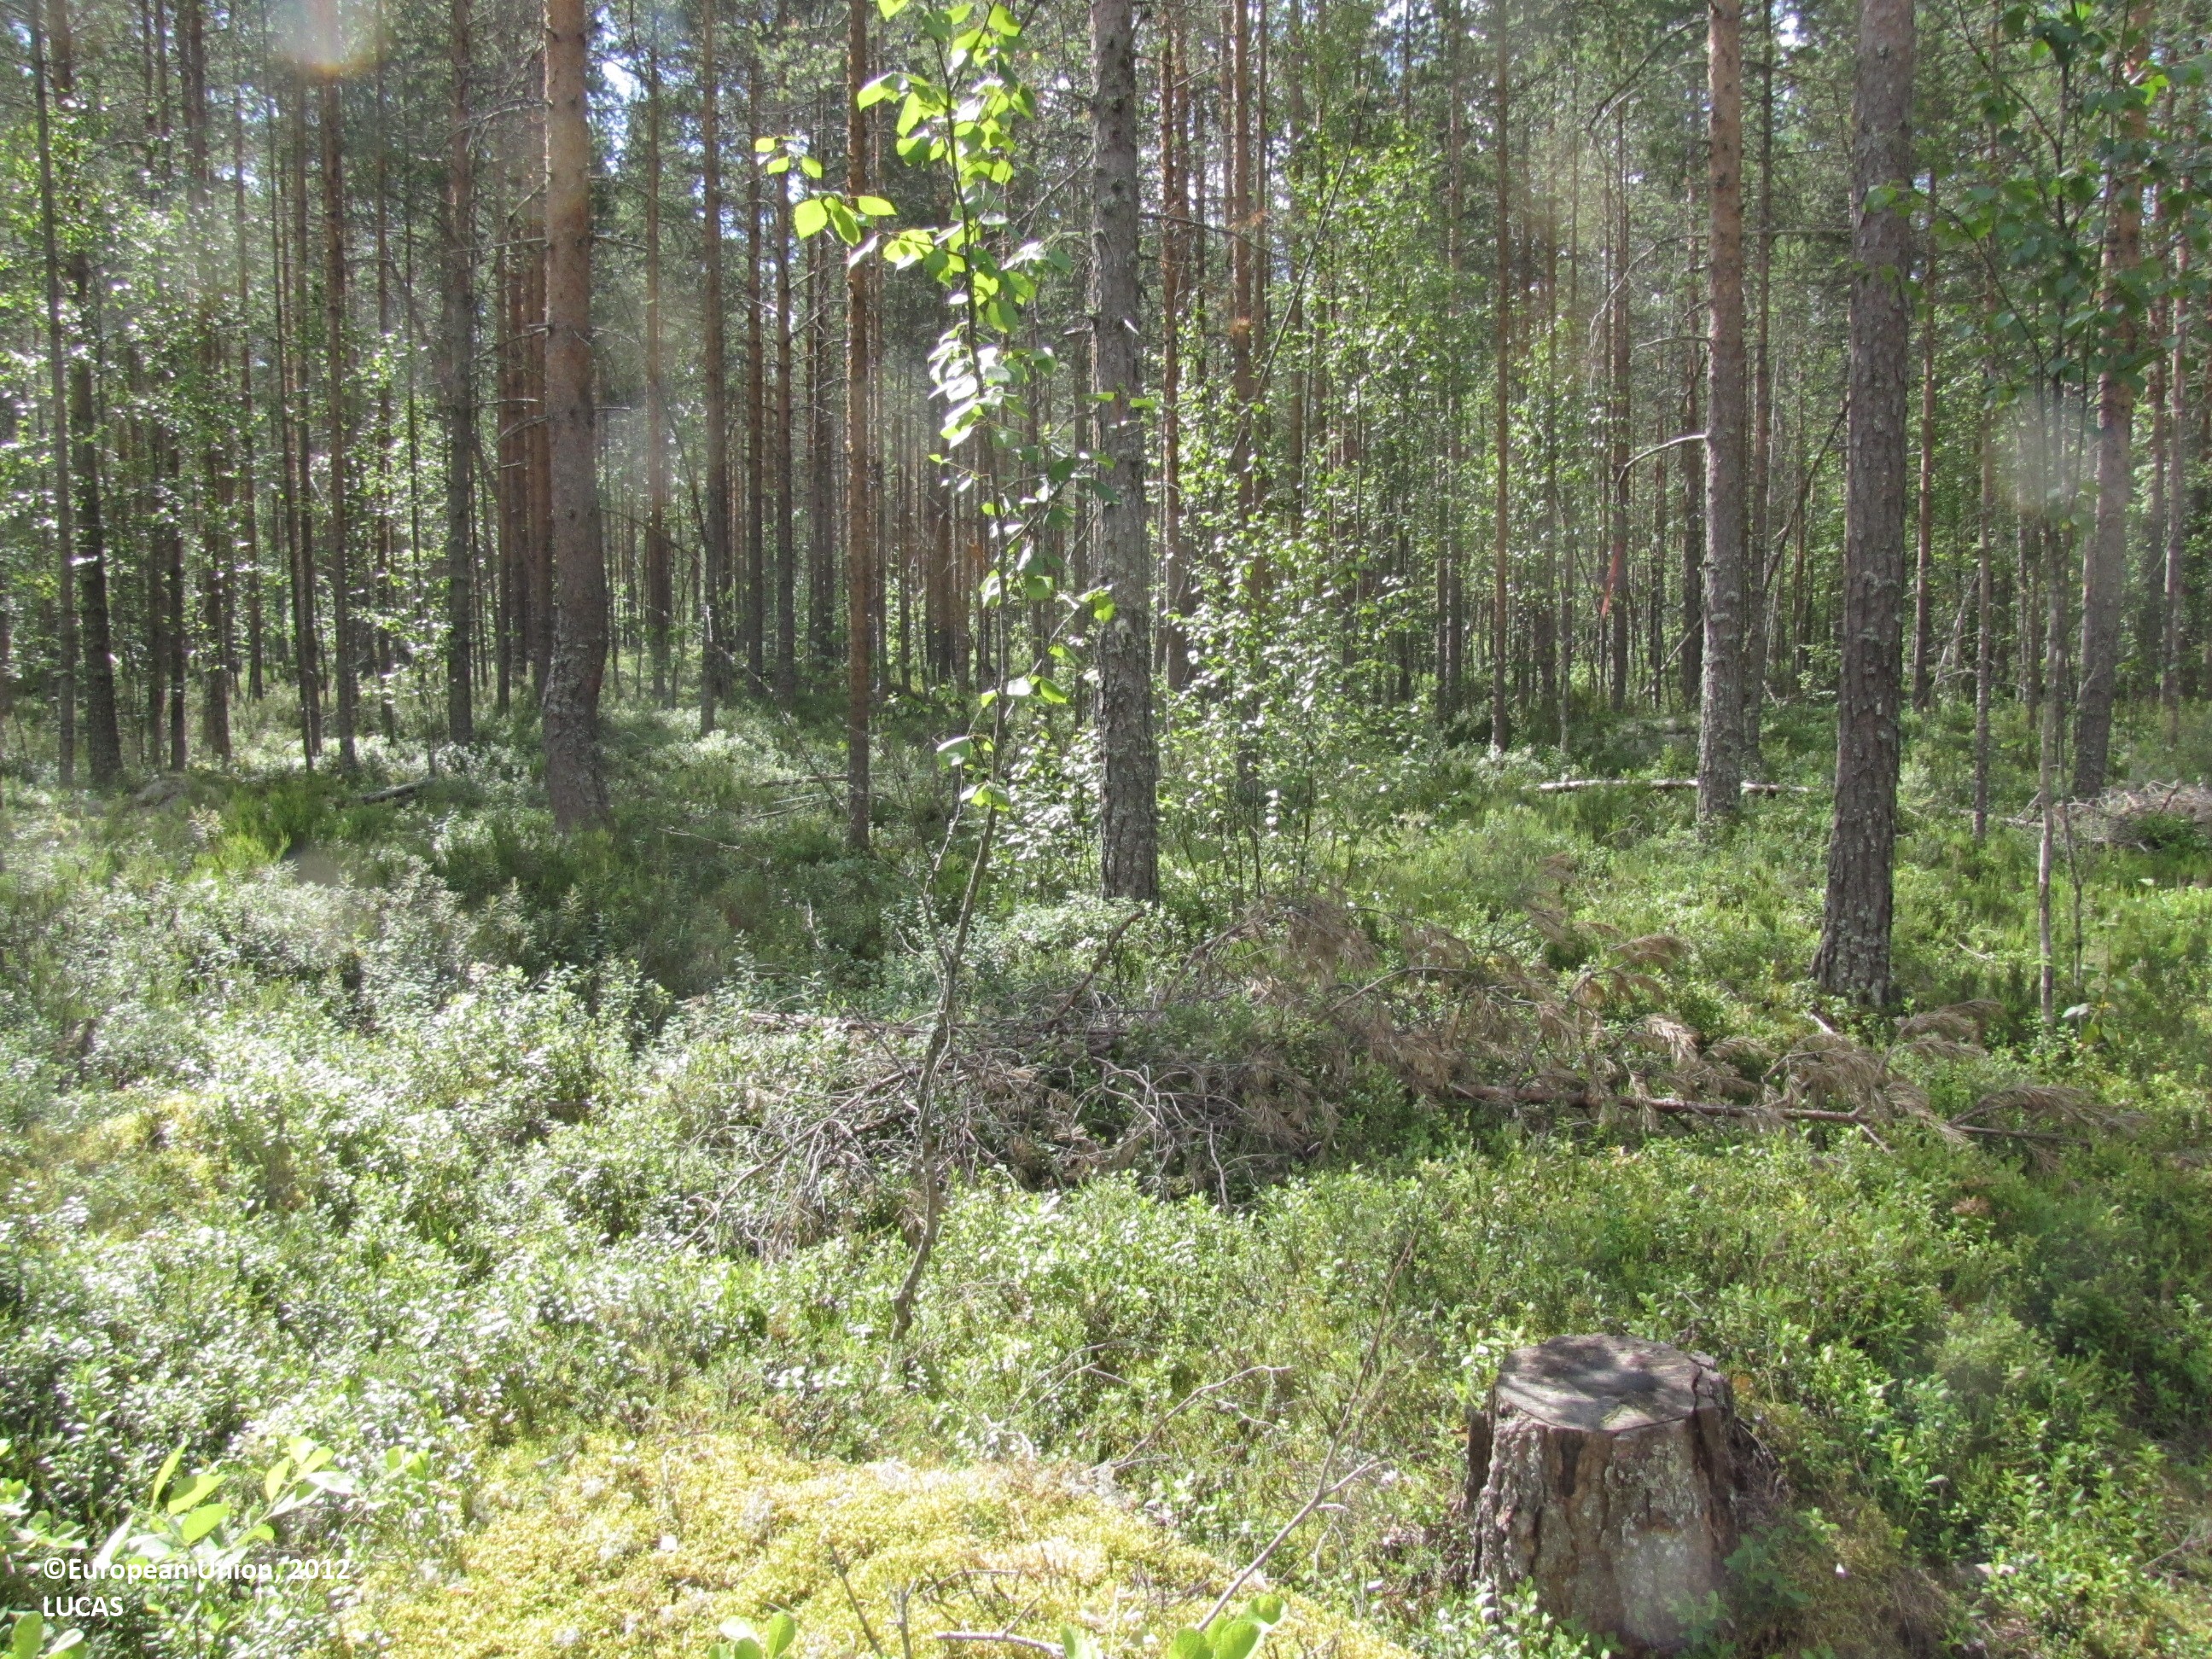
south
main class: Woodland
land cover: Pine dominated coniferous woodland
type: boreal forest
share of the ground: 50 - 75 %
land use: Forestry
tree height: > 5 m
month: July
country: FI
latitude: 62.6692
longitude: 23.2039
